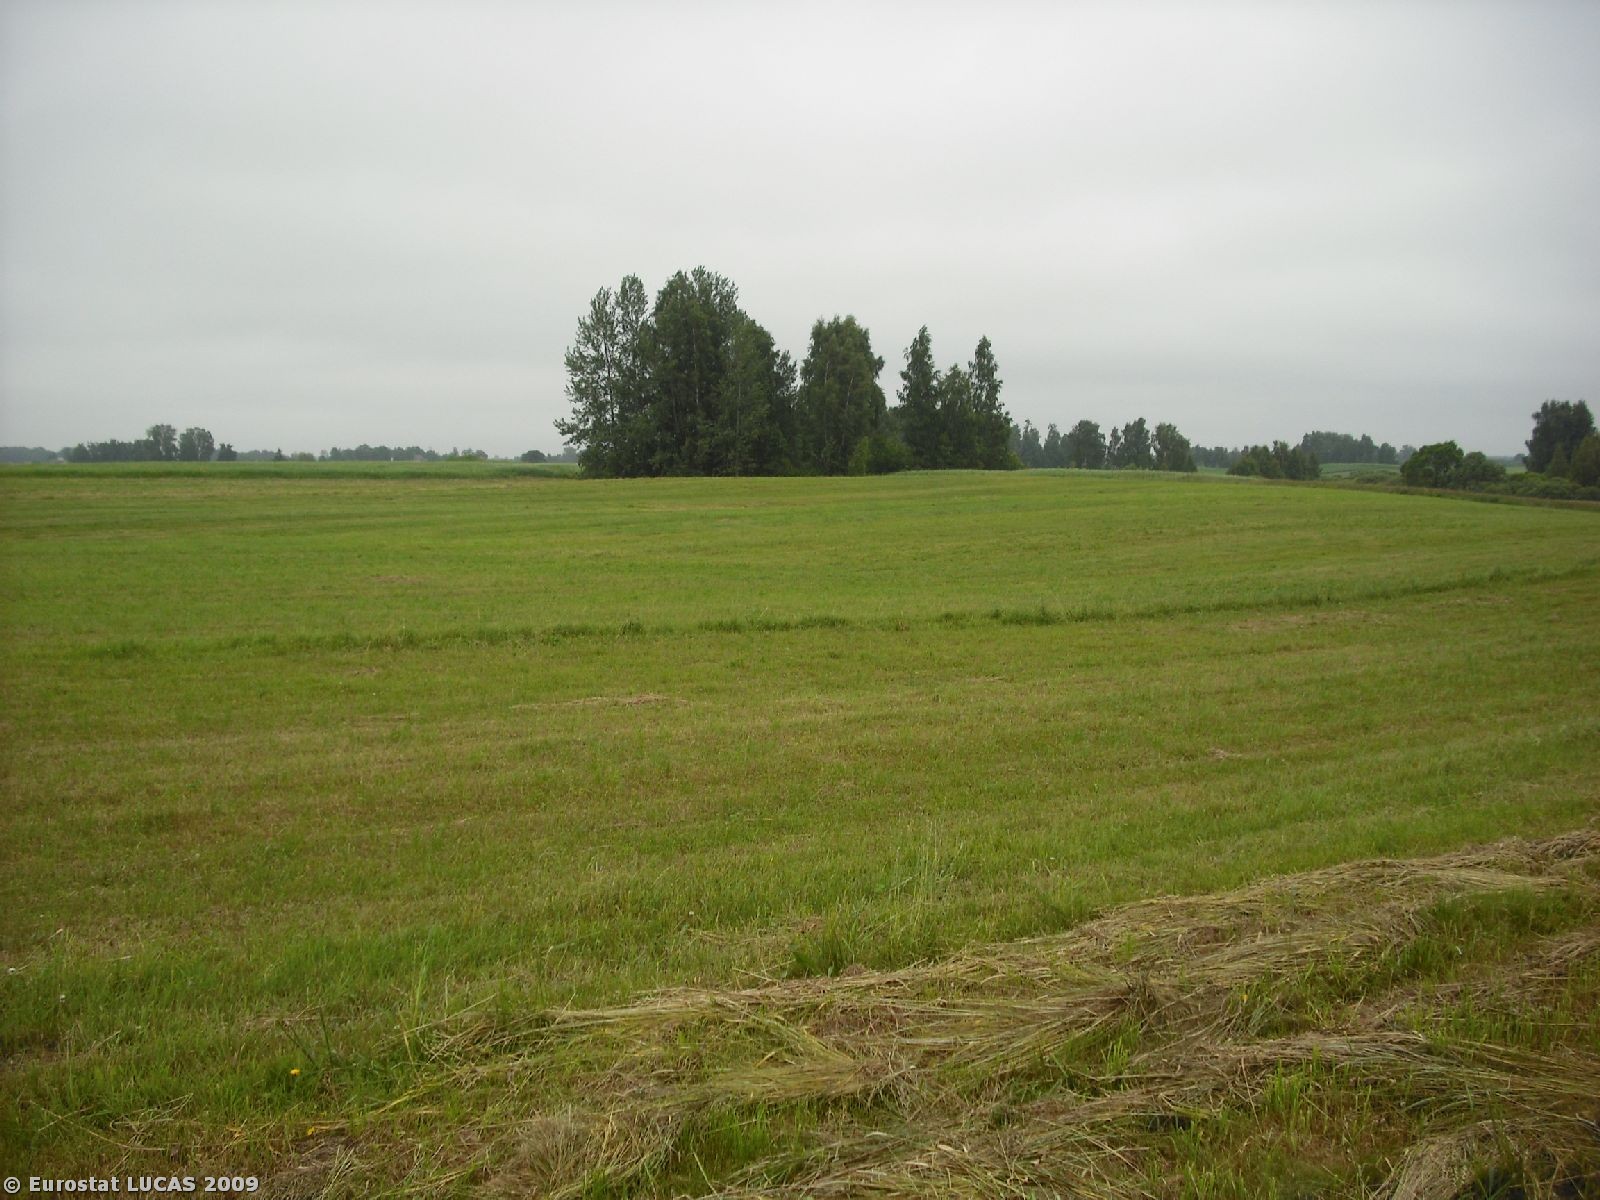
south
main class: Grassland
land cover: Grassland without tree/shrub cover
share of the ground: > 75 %
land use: Agriculture (excluding fallow land and kitchen gardens)
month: June
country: PL
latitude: 53.9583
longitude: 22.7956
